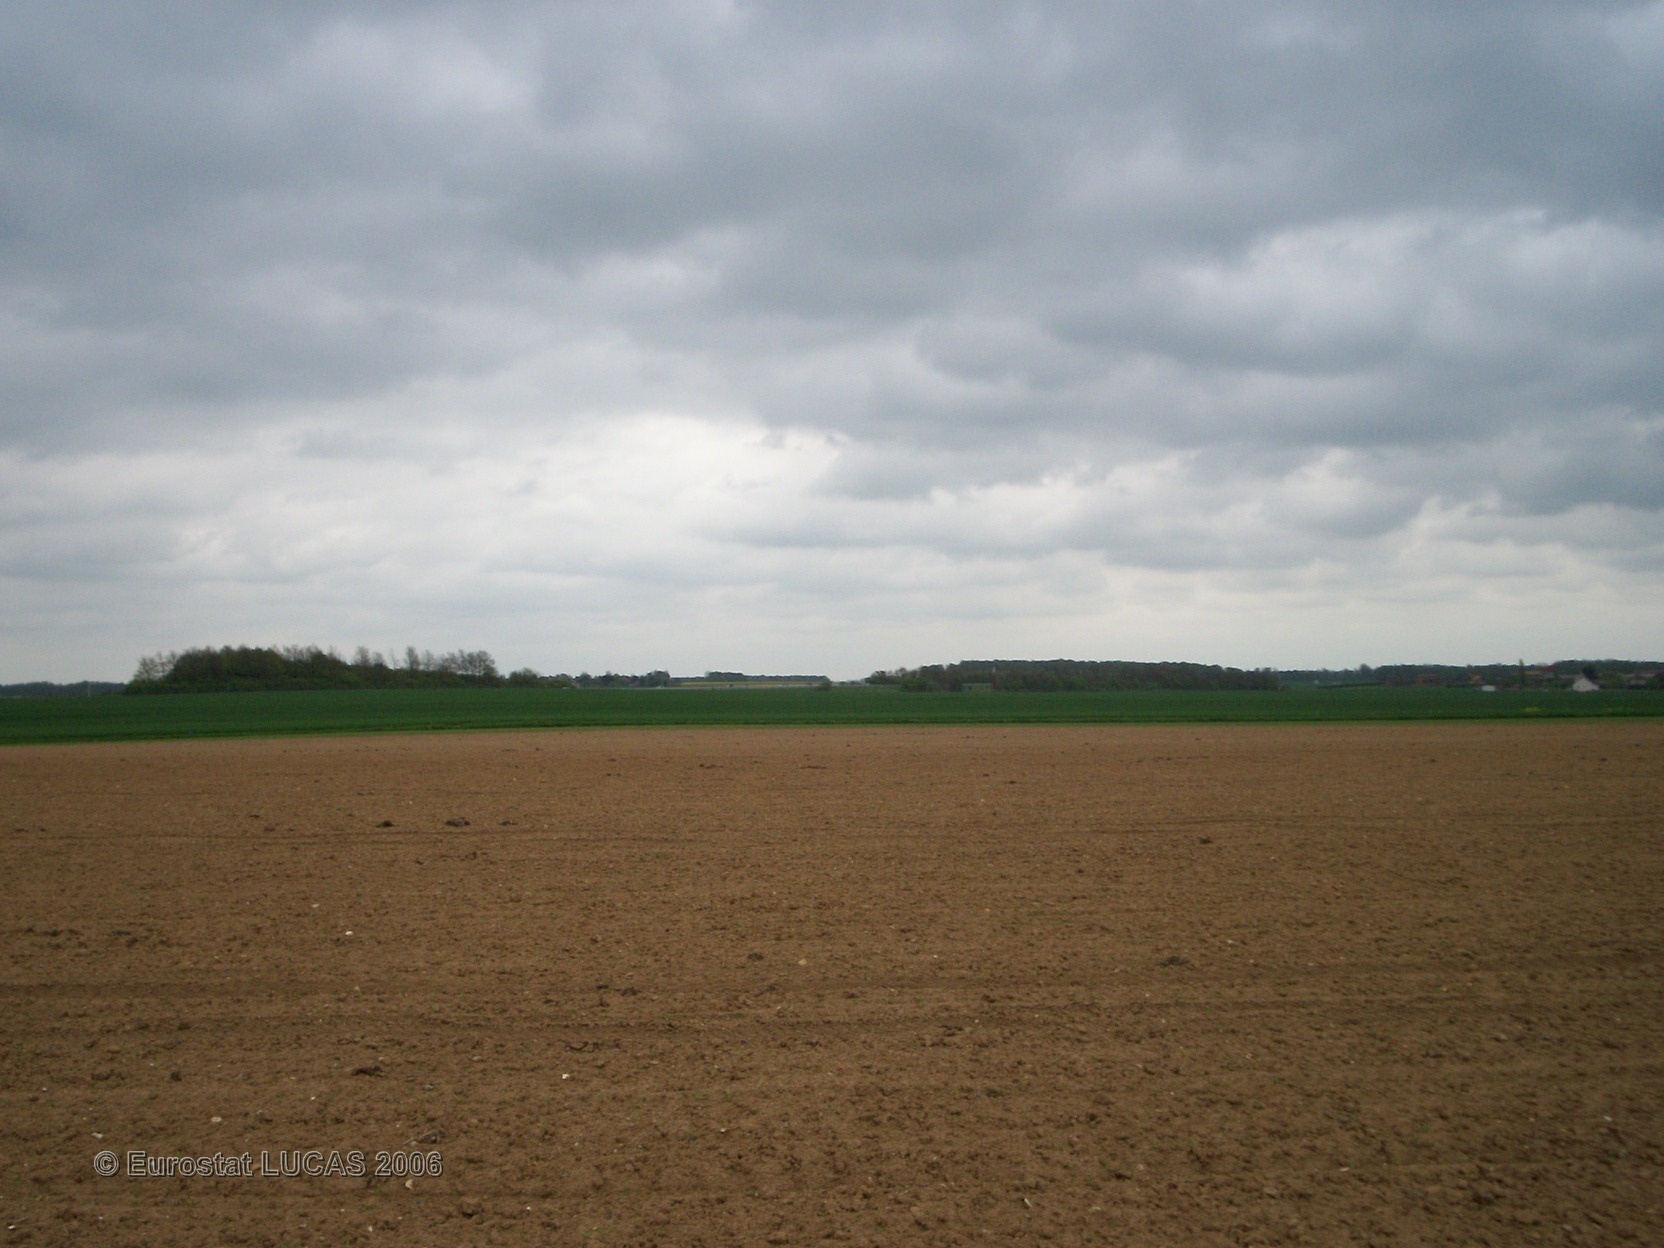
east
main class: Cropland
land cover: Sugar beet
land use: Agriculture (excluding fallow land and kitchen gardens)
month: May
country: FR
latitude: 48.1558
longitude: 2.8807
